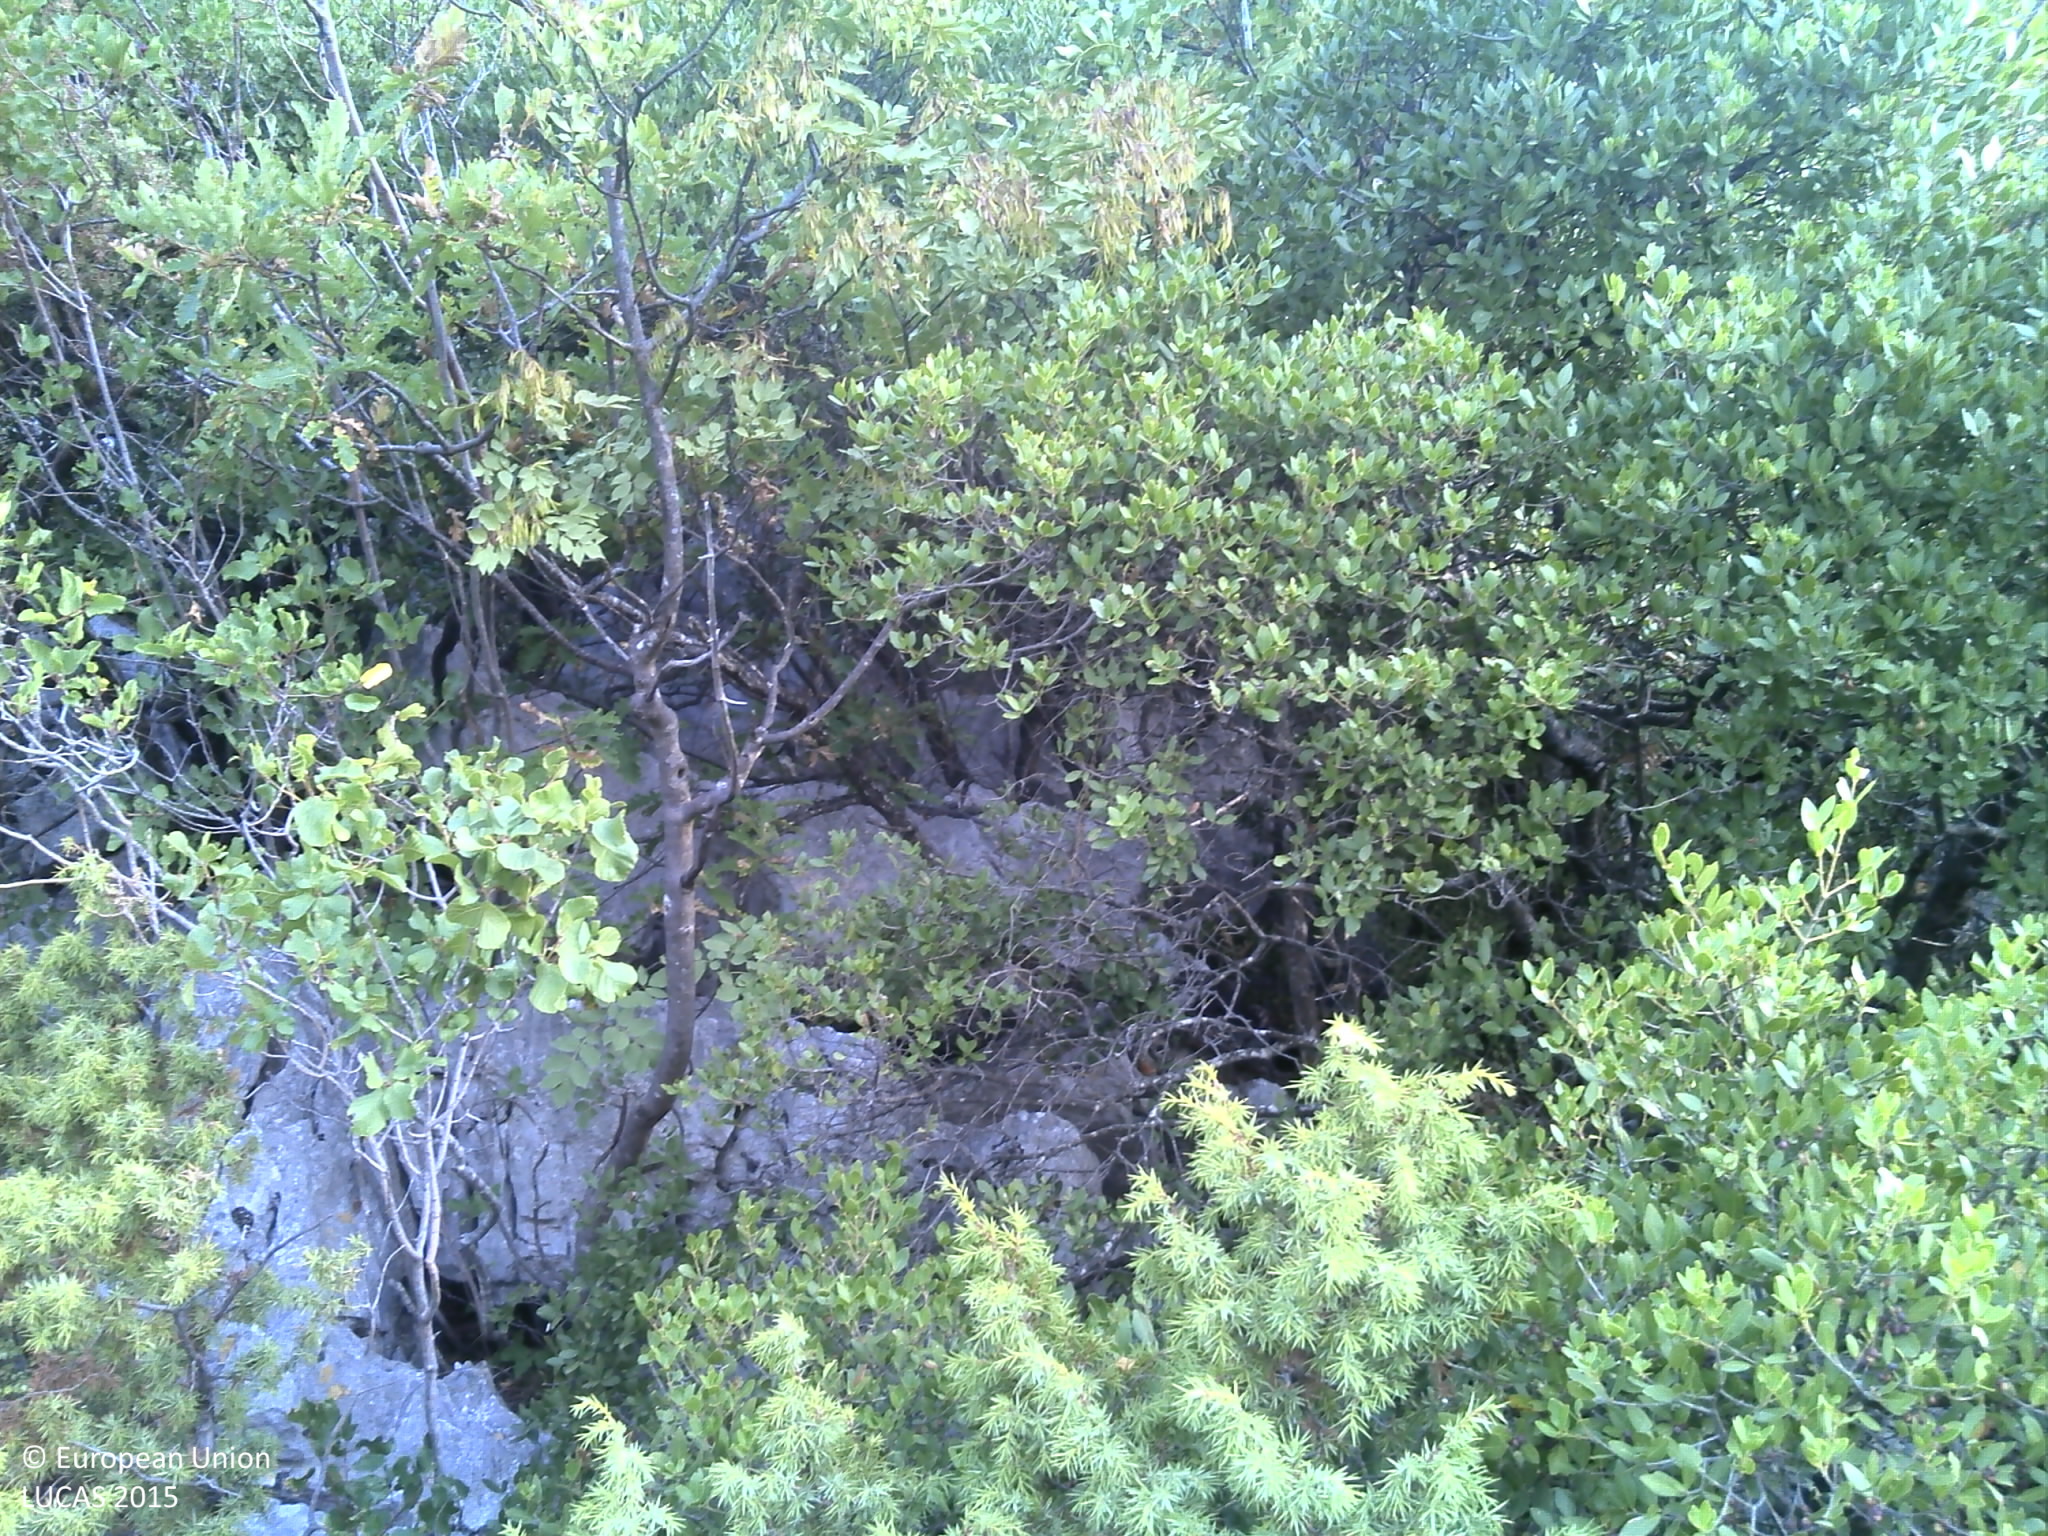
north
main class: Shrubland
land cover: Shrubland with sparse tree cover
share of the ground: > 75 %
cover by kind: shrubs 65 %, unconsolidated bare surface 15 %, consolidated bare surface 10 %, broadleaved forest trees 5 %, herbaceous plants 5 %
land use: Semi-natural and natural areas not in use
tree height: < 5 m
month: August
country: HR
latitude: 43.2118
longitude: 17.2163
